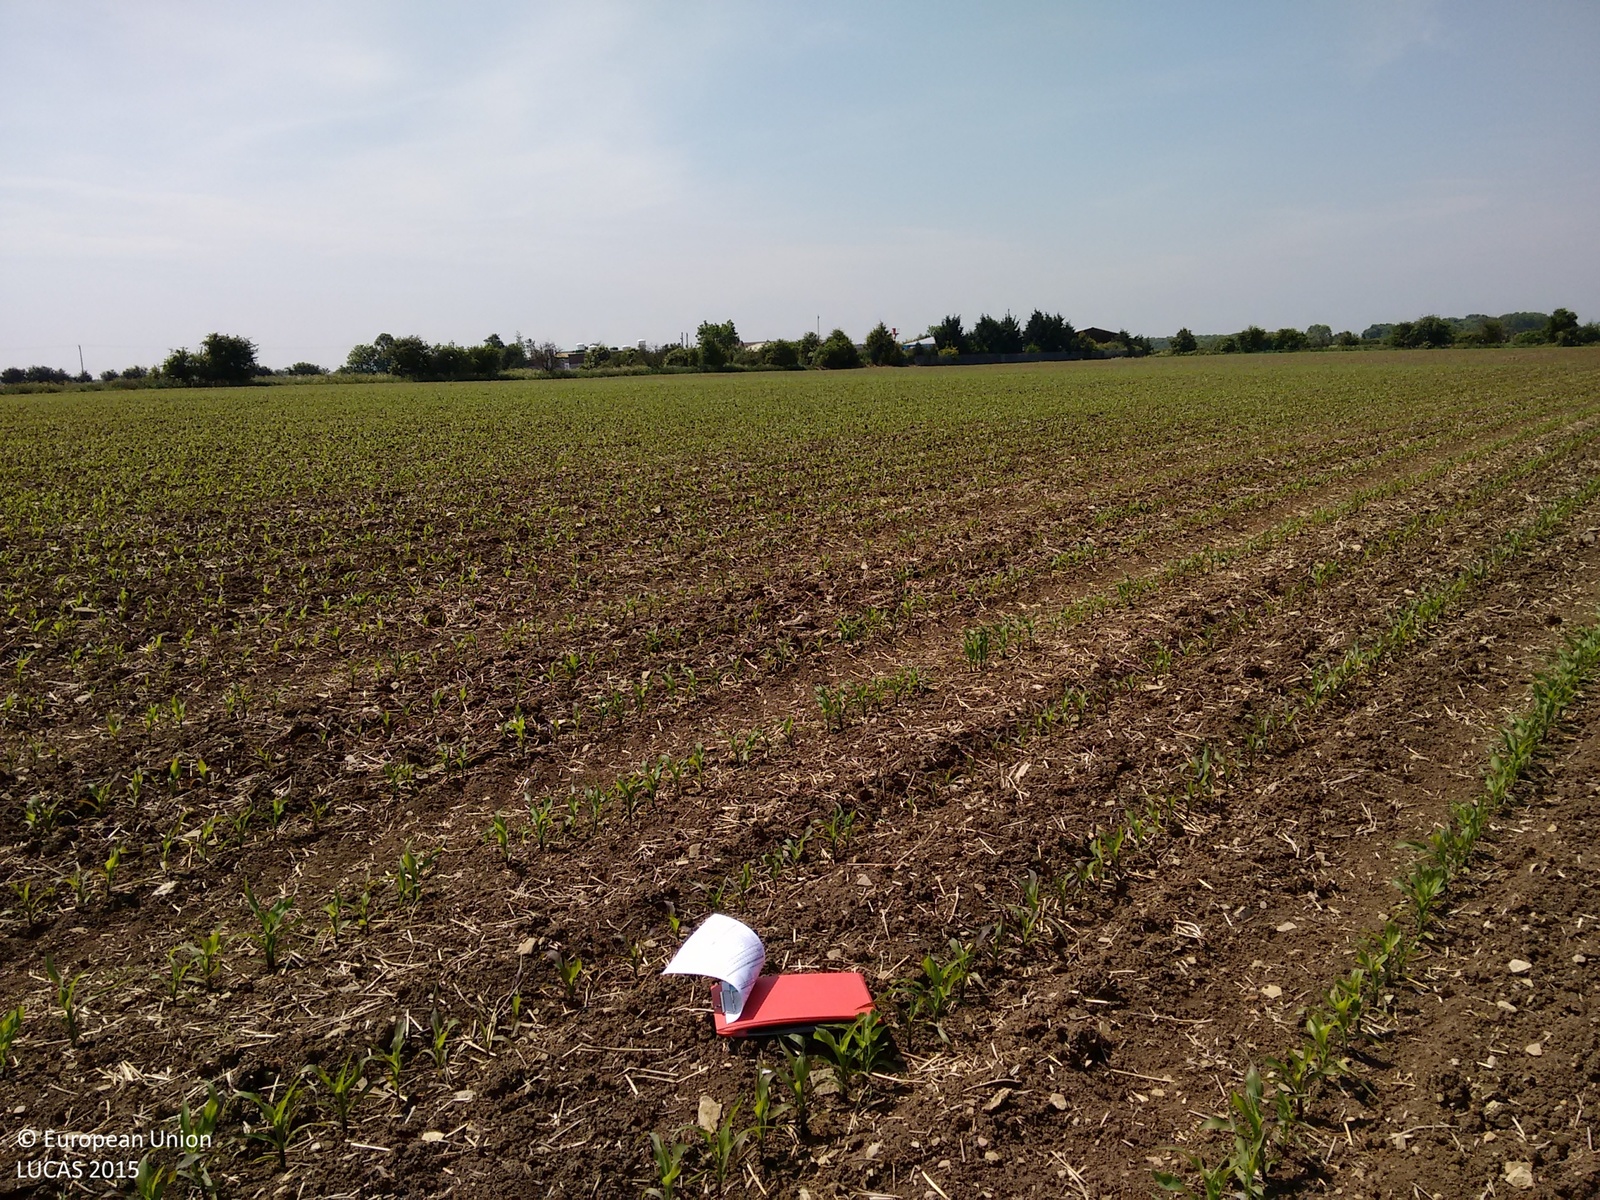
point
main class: Cropland
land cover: Maize
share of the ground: 10 - 25 %
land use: Agriculture (excluding fallow land and kitchen gardens)
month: June
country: GB
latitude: 53.0093
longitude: -0.7868
